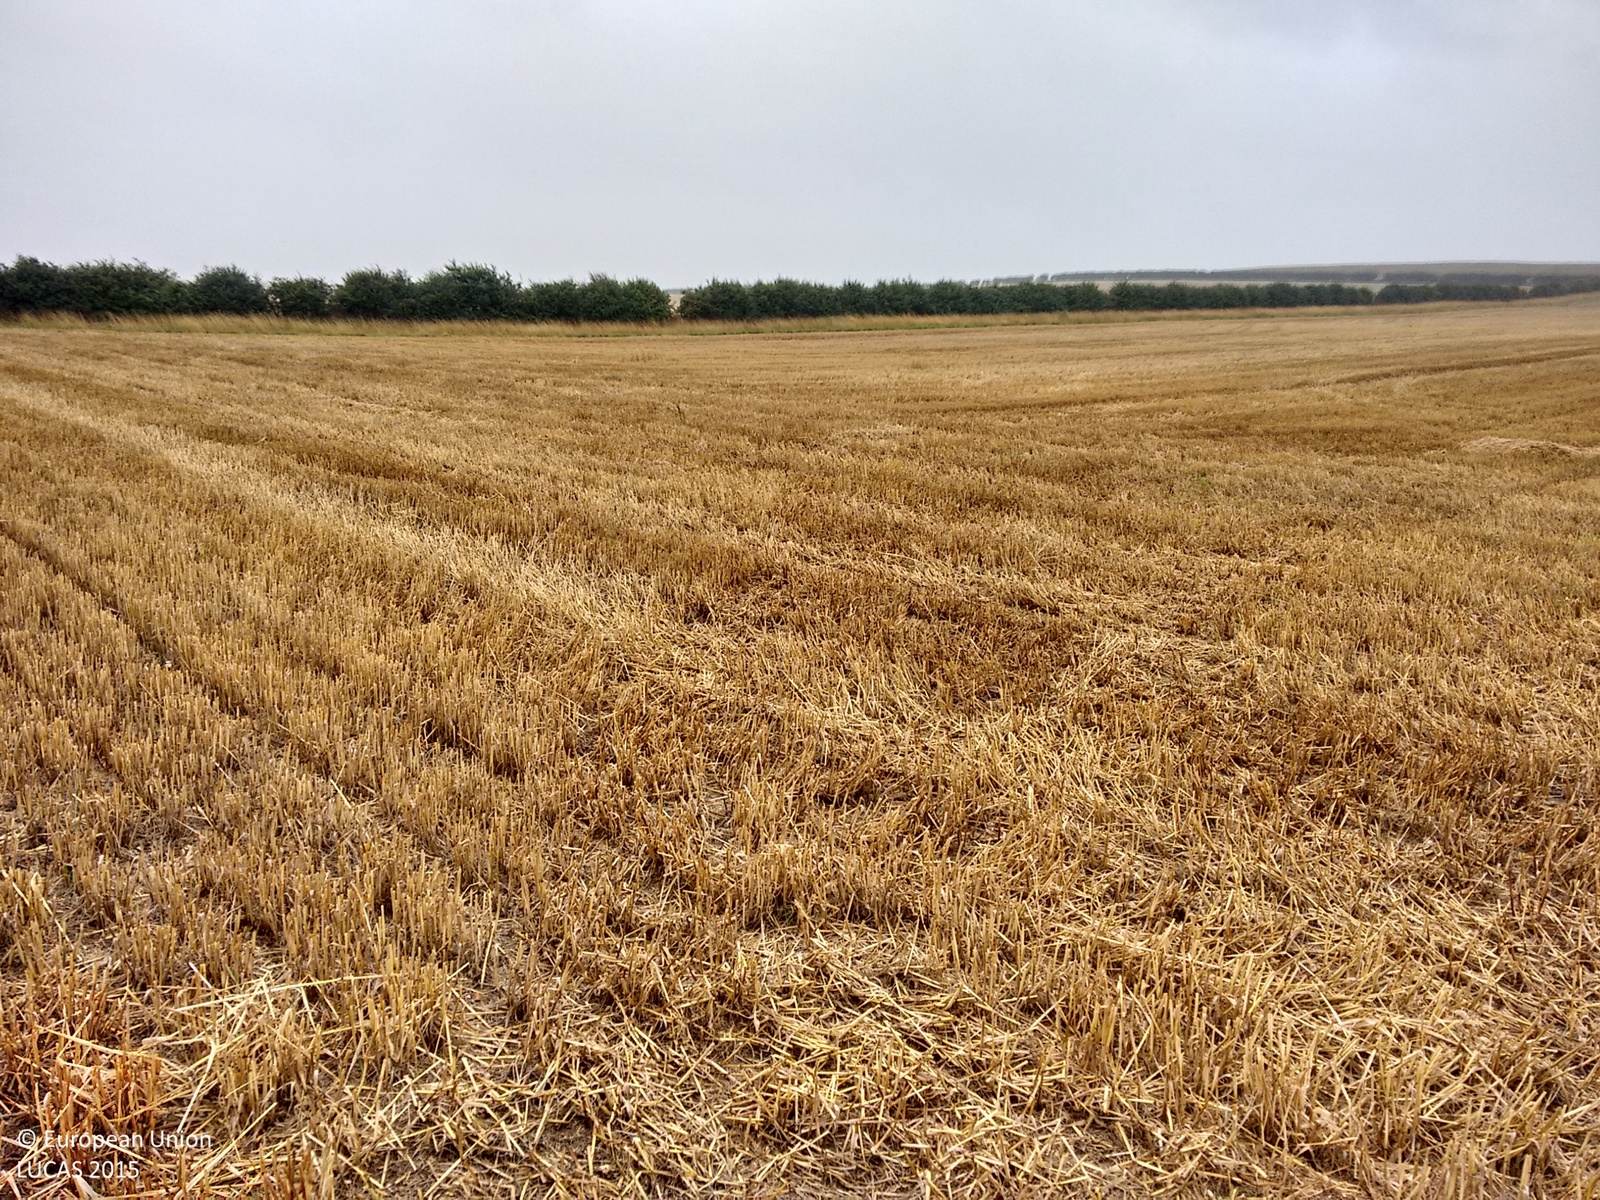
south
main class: Cropland
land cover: Common wheat
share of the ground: > 75 %
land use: Agriculture (excluding fallow land and kitchen gardens)
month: August
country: GB
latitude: 52.9375
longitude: 0.7350
